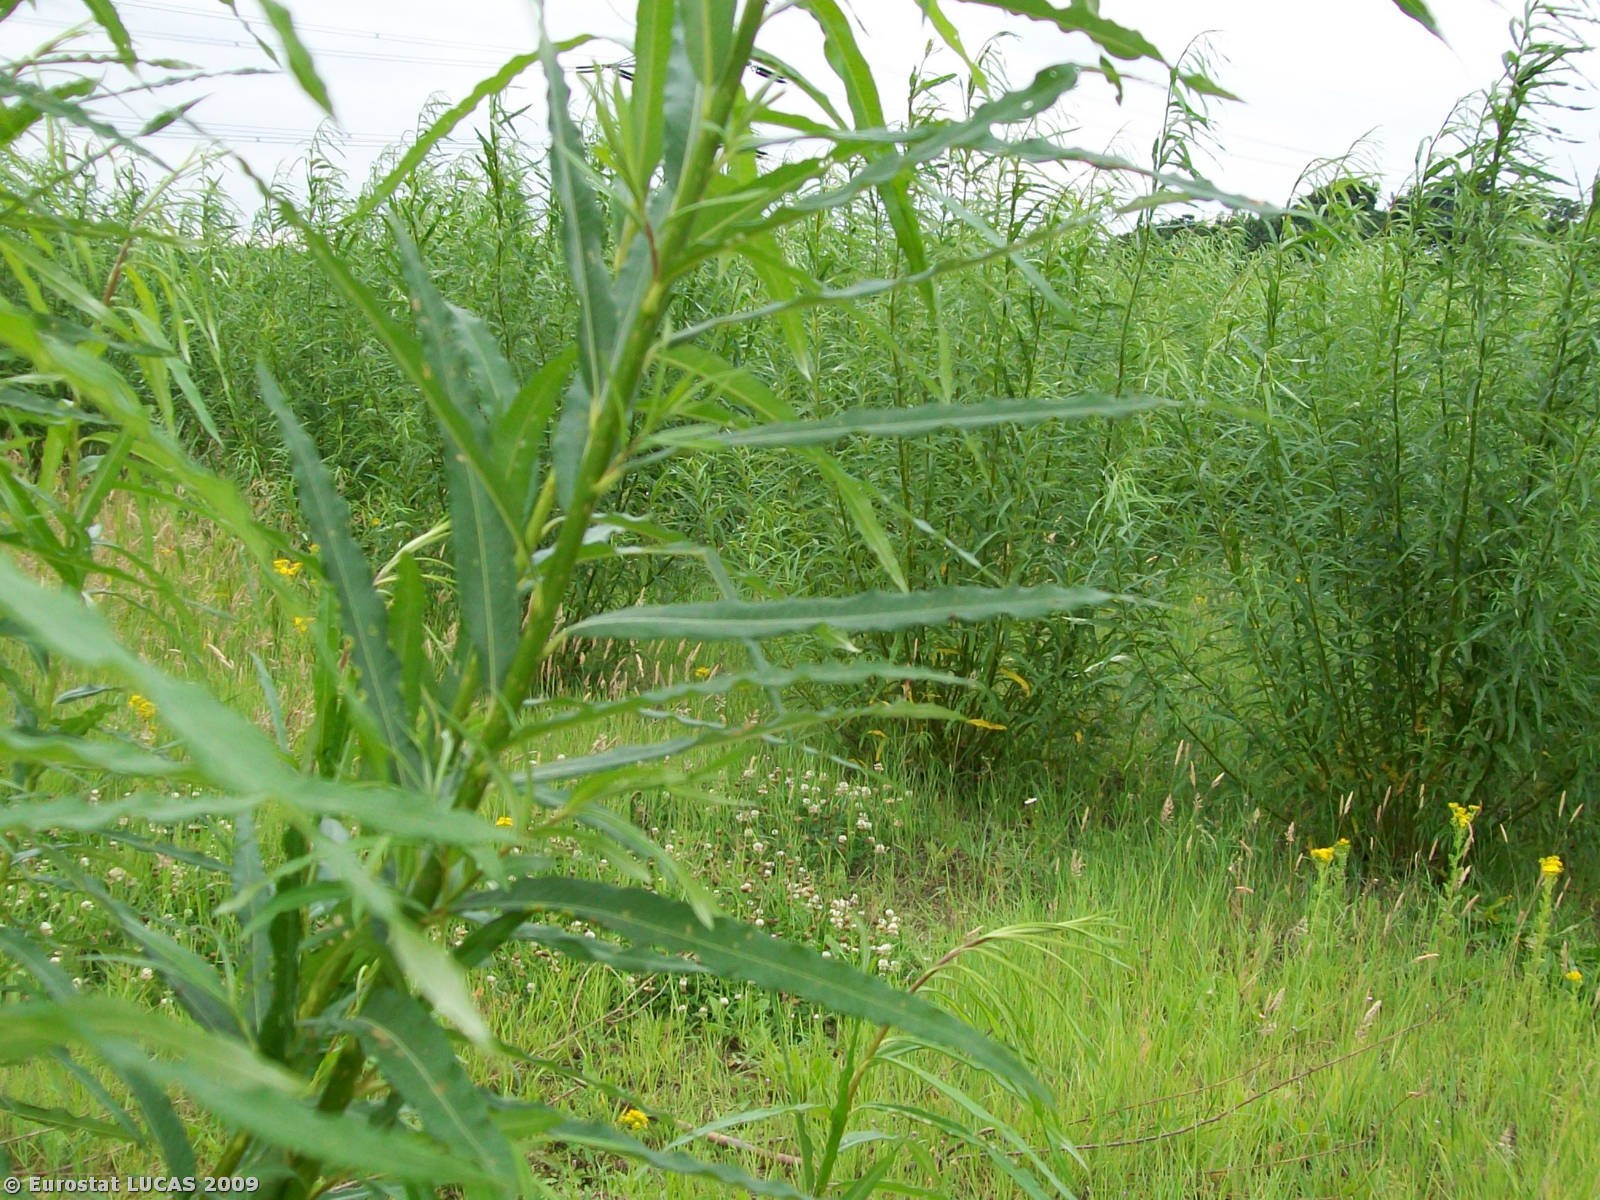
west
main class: Woodland
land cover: Broadleaved woodland
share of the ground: 50 - 75 %
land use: Energy production
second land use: Forestry
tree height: > 5 m
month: July
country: GB
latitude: 53.7361
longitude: -1.3724
